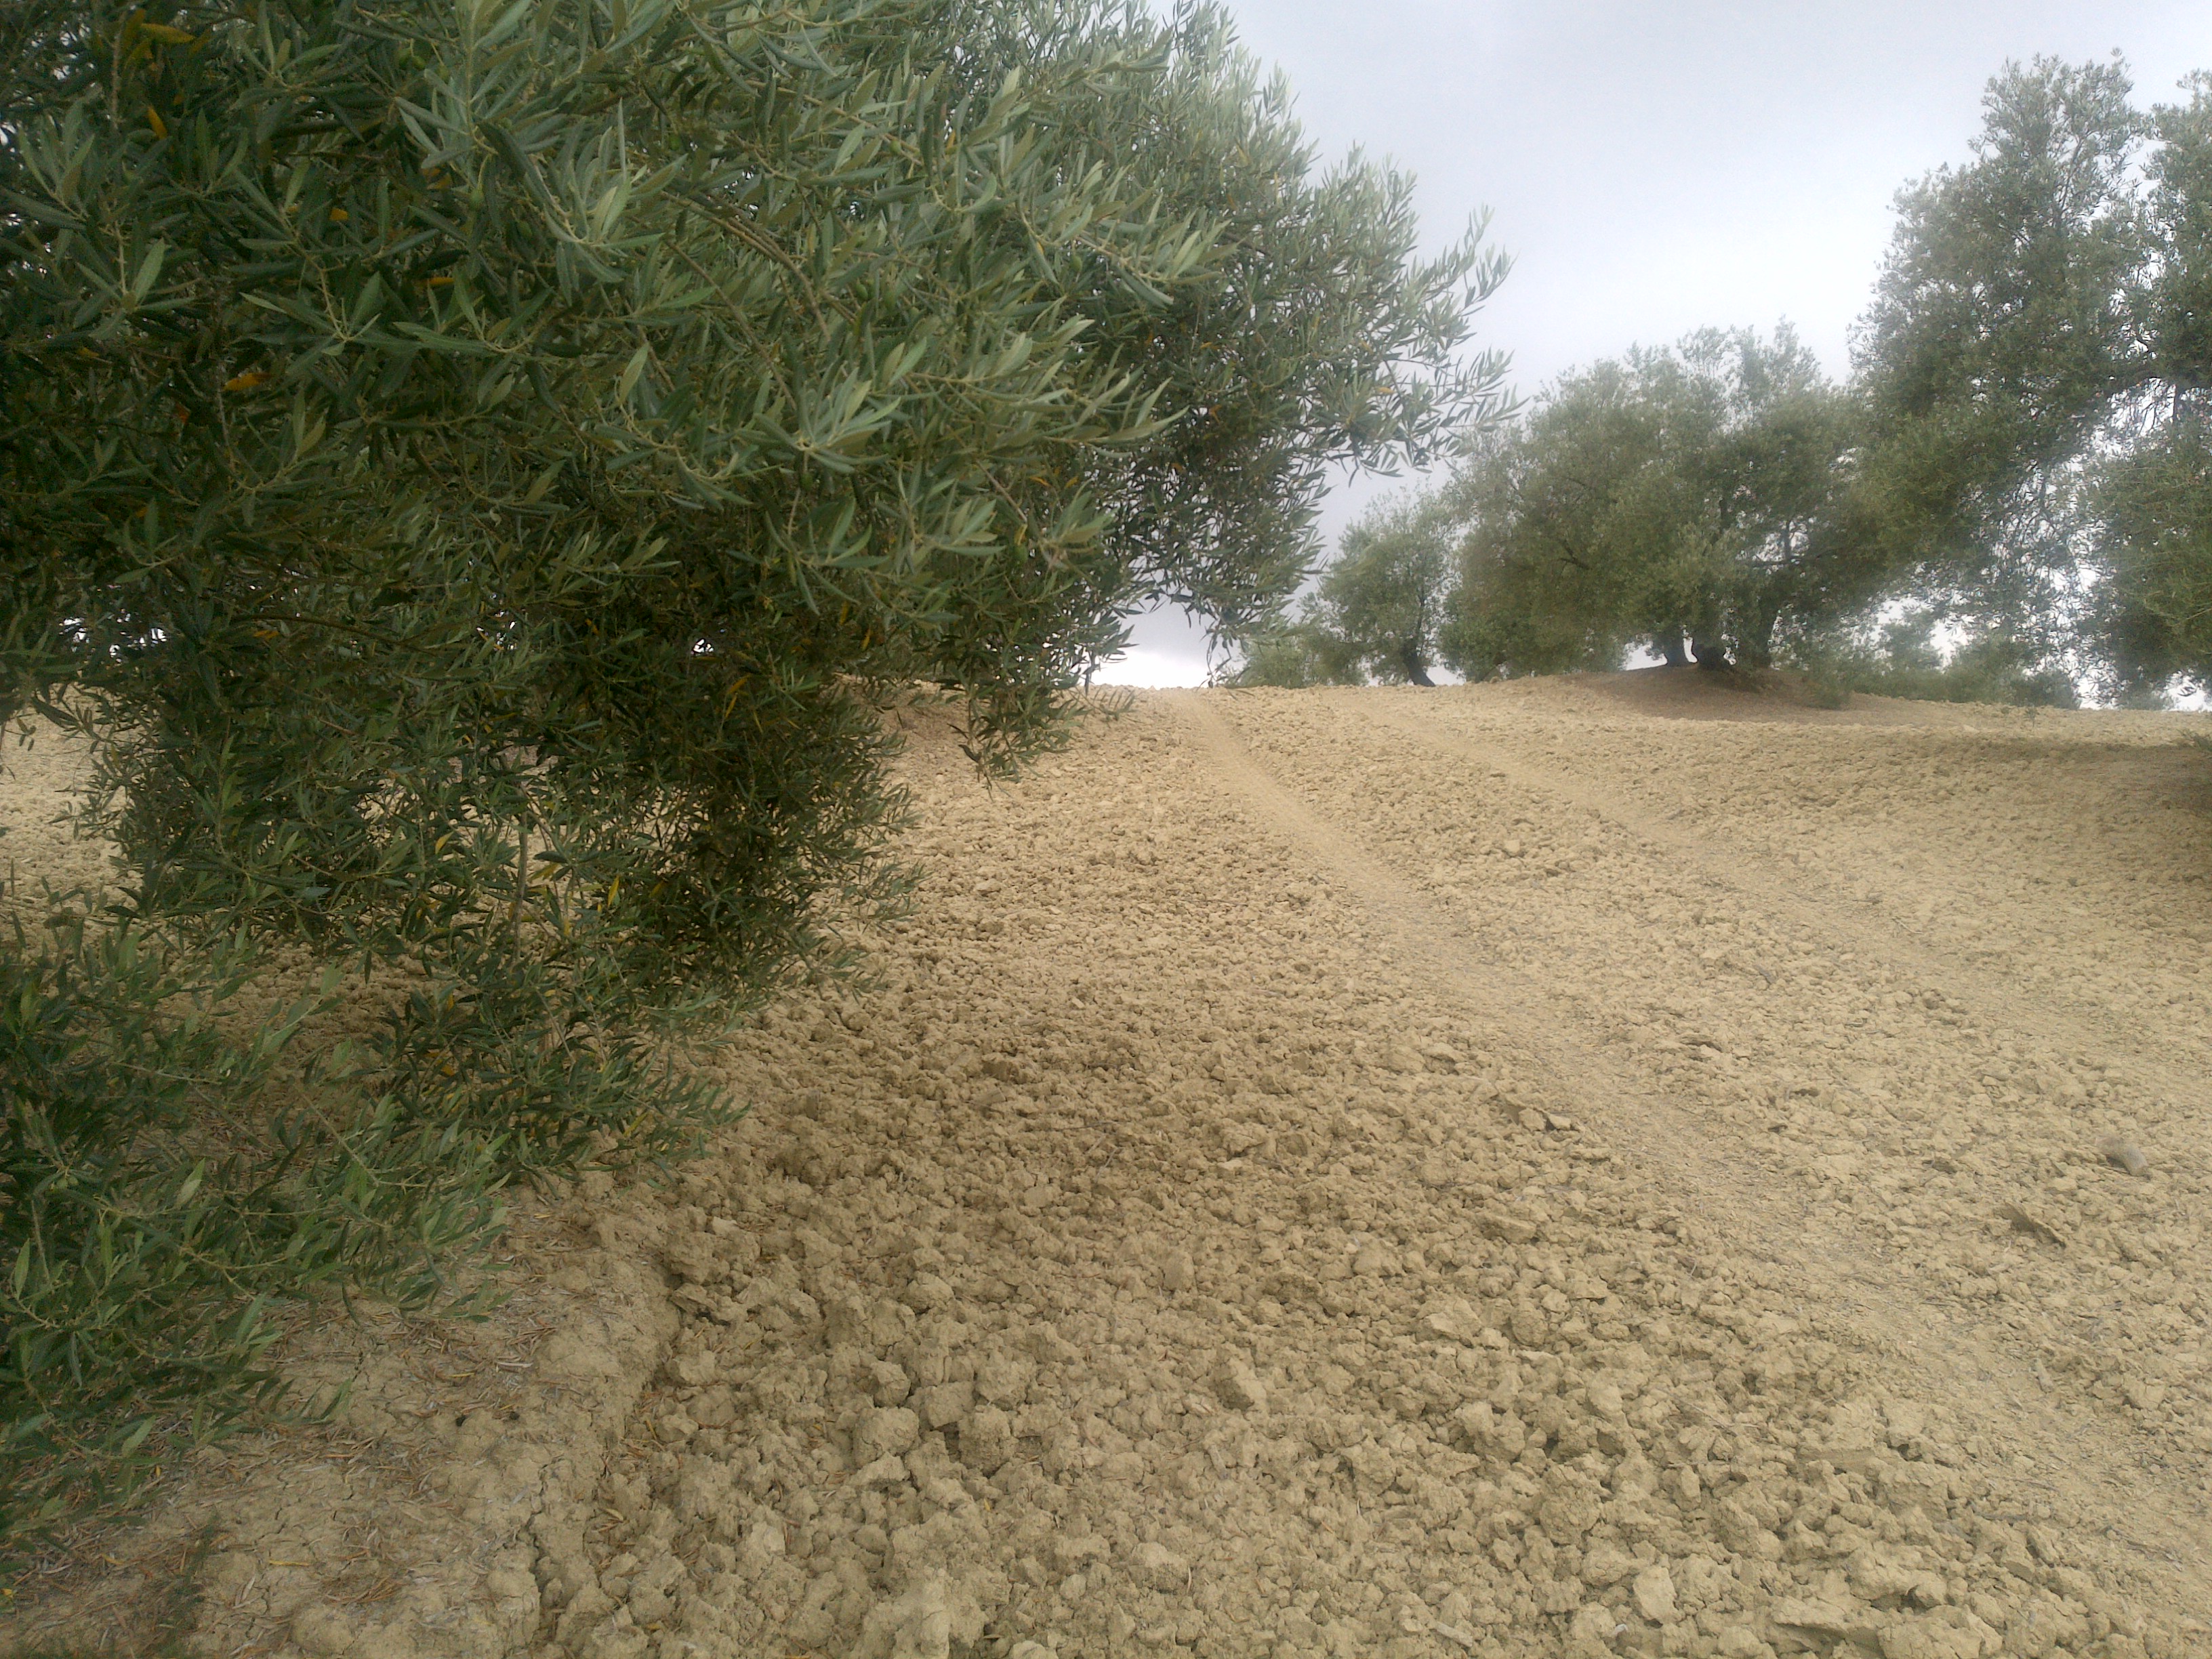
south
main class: Cropland
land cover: Olive groves
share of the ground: 50 - 75 %
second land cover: Other bare soil
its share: > 75 %
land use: Agriculture (excluding fallow land and kitchen gardens)
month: June
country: ES
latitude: 37.8918
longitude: -4.3020
